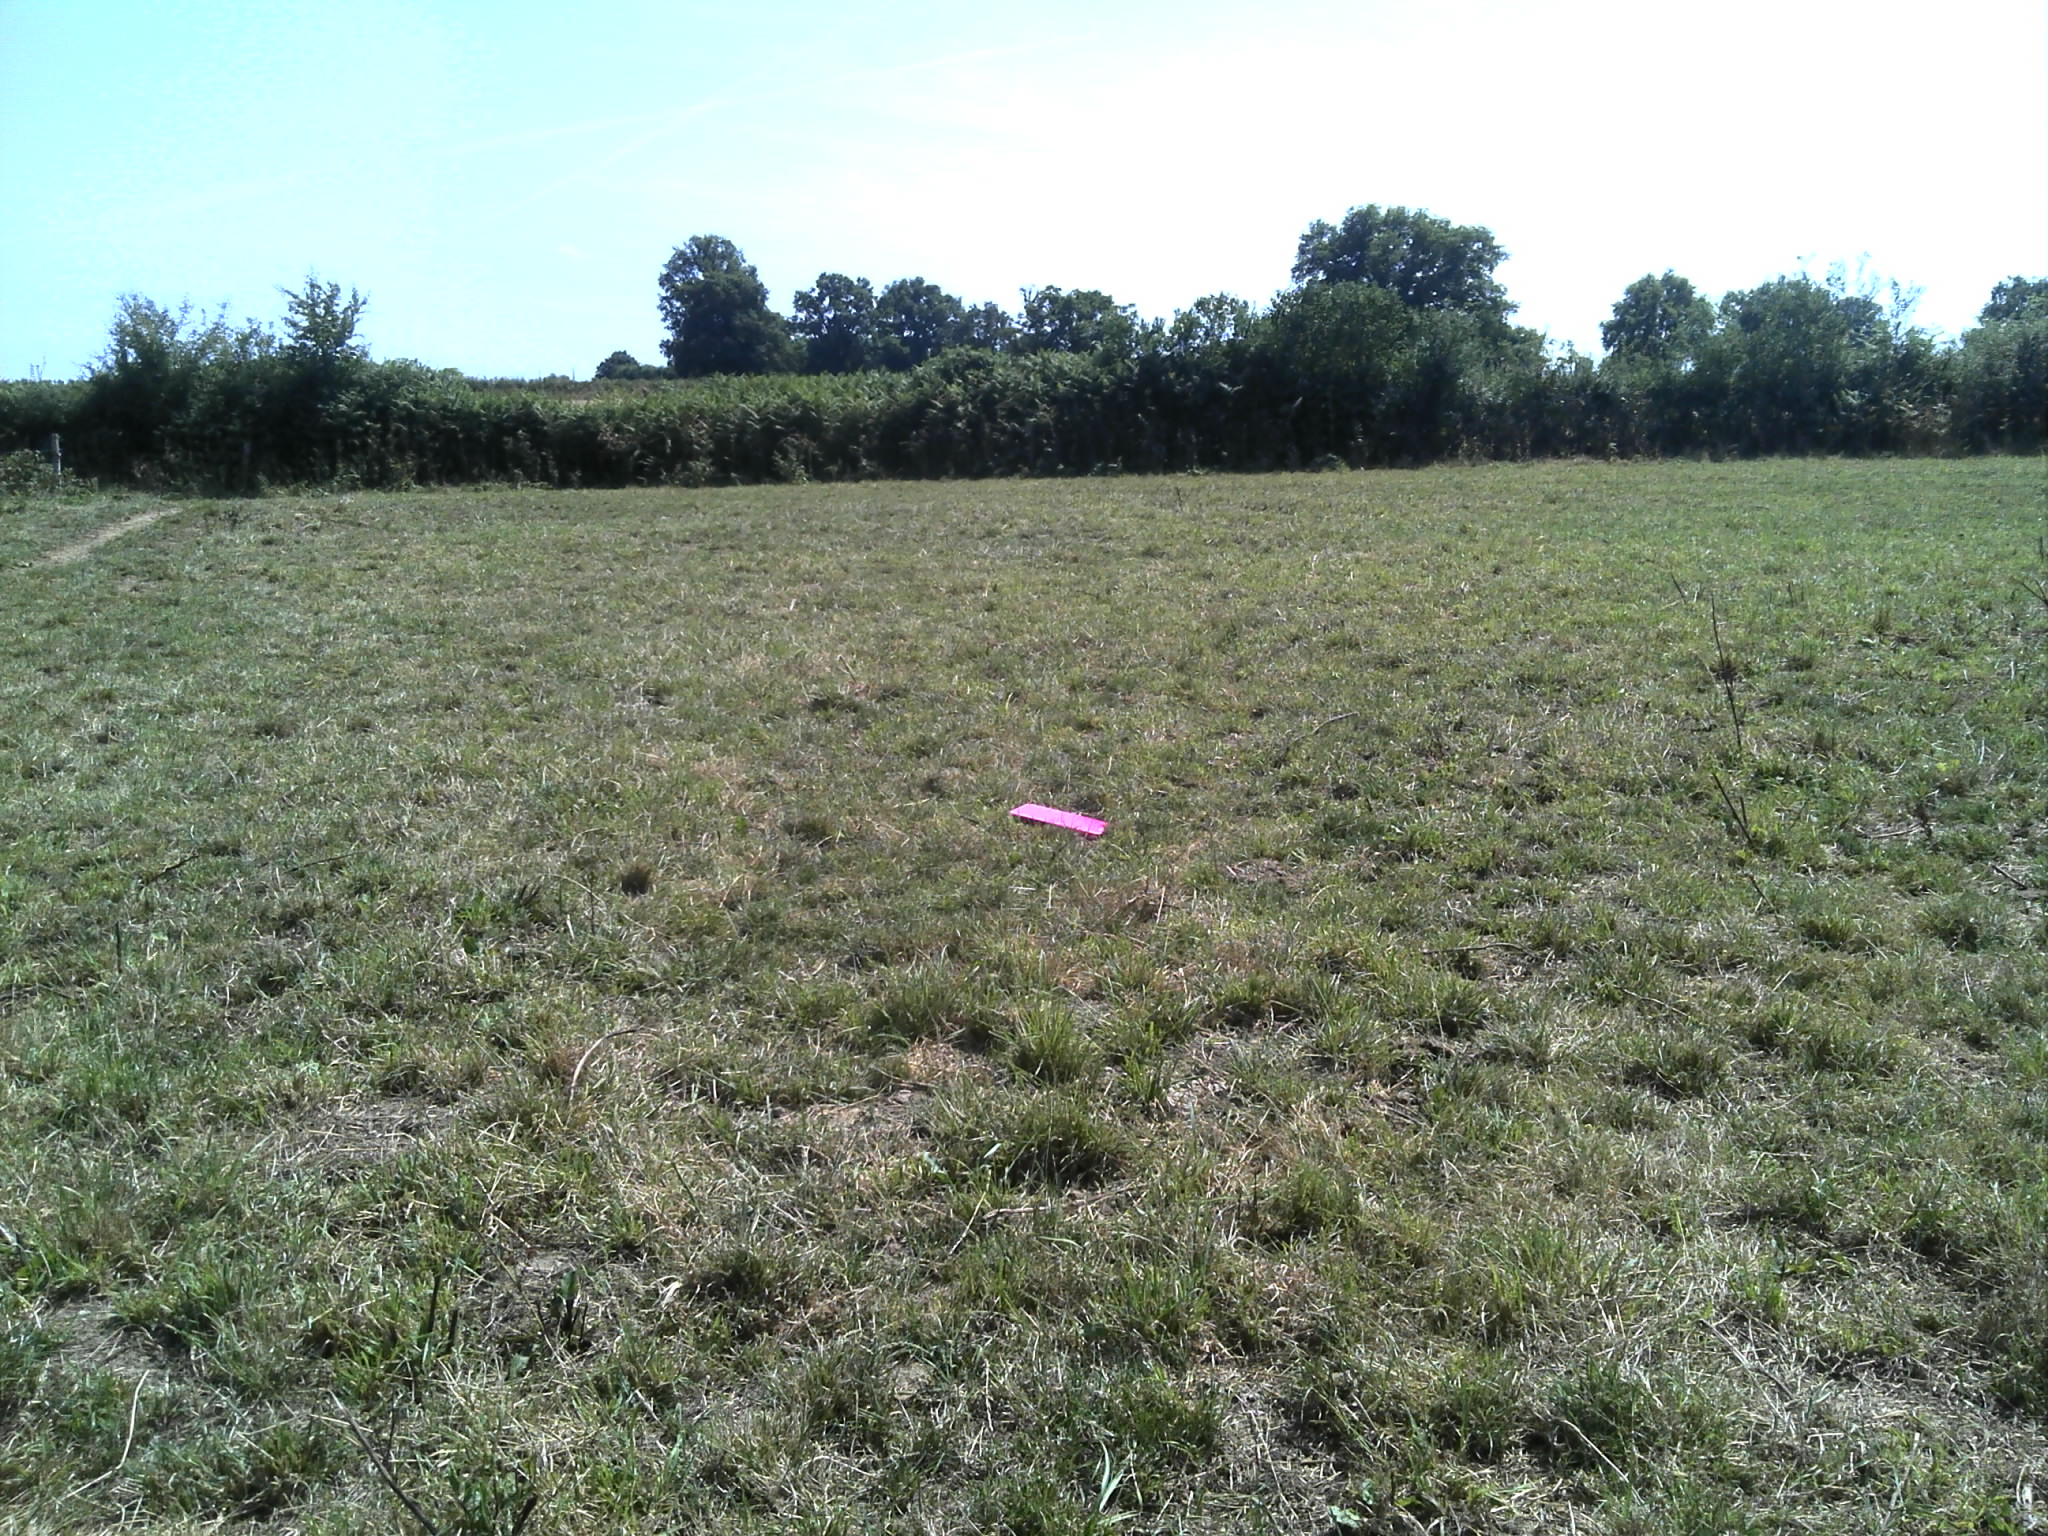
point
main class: Grassland
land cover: Grassland without tree/shrub cover
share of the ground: > 75 %
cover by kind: herbaceous plants 100 %
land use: Agriculture (excluding fallow land and kitchen gardens)
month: August
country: FR
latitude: 46.4803
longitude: 1.6937
